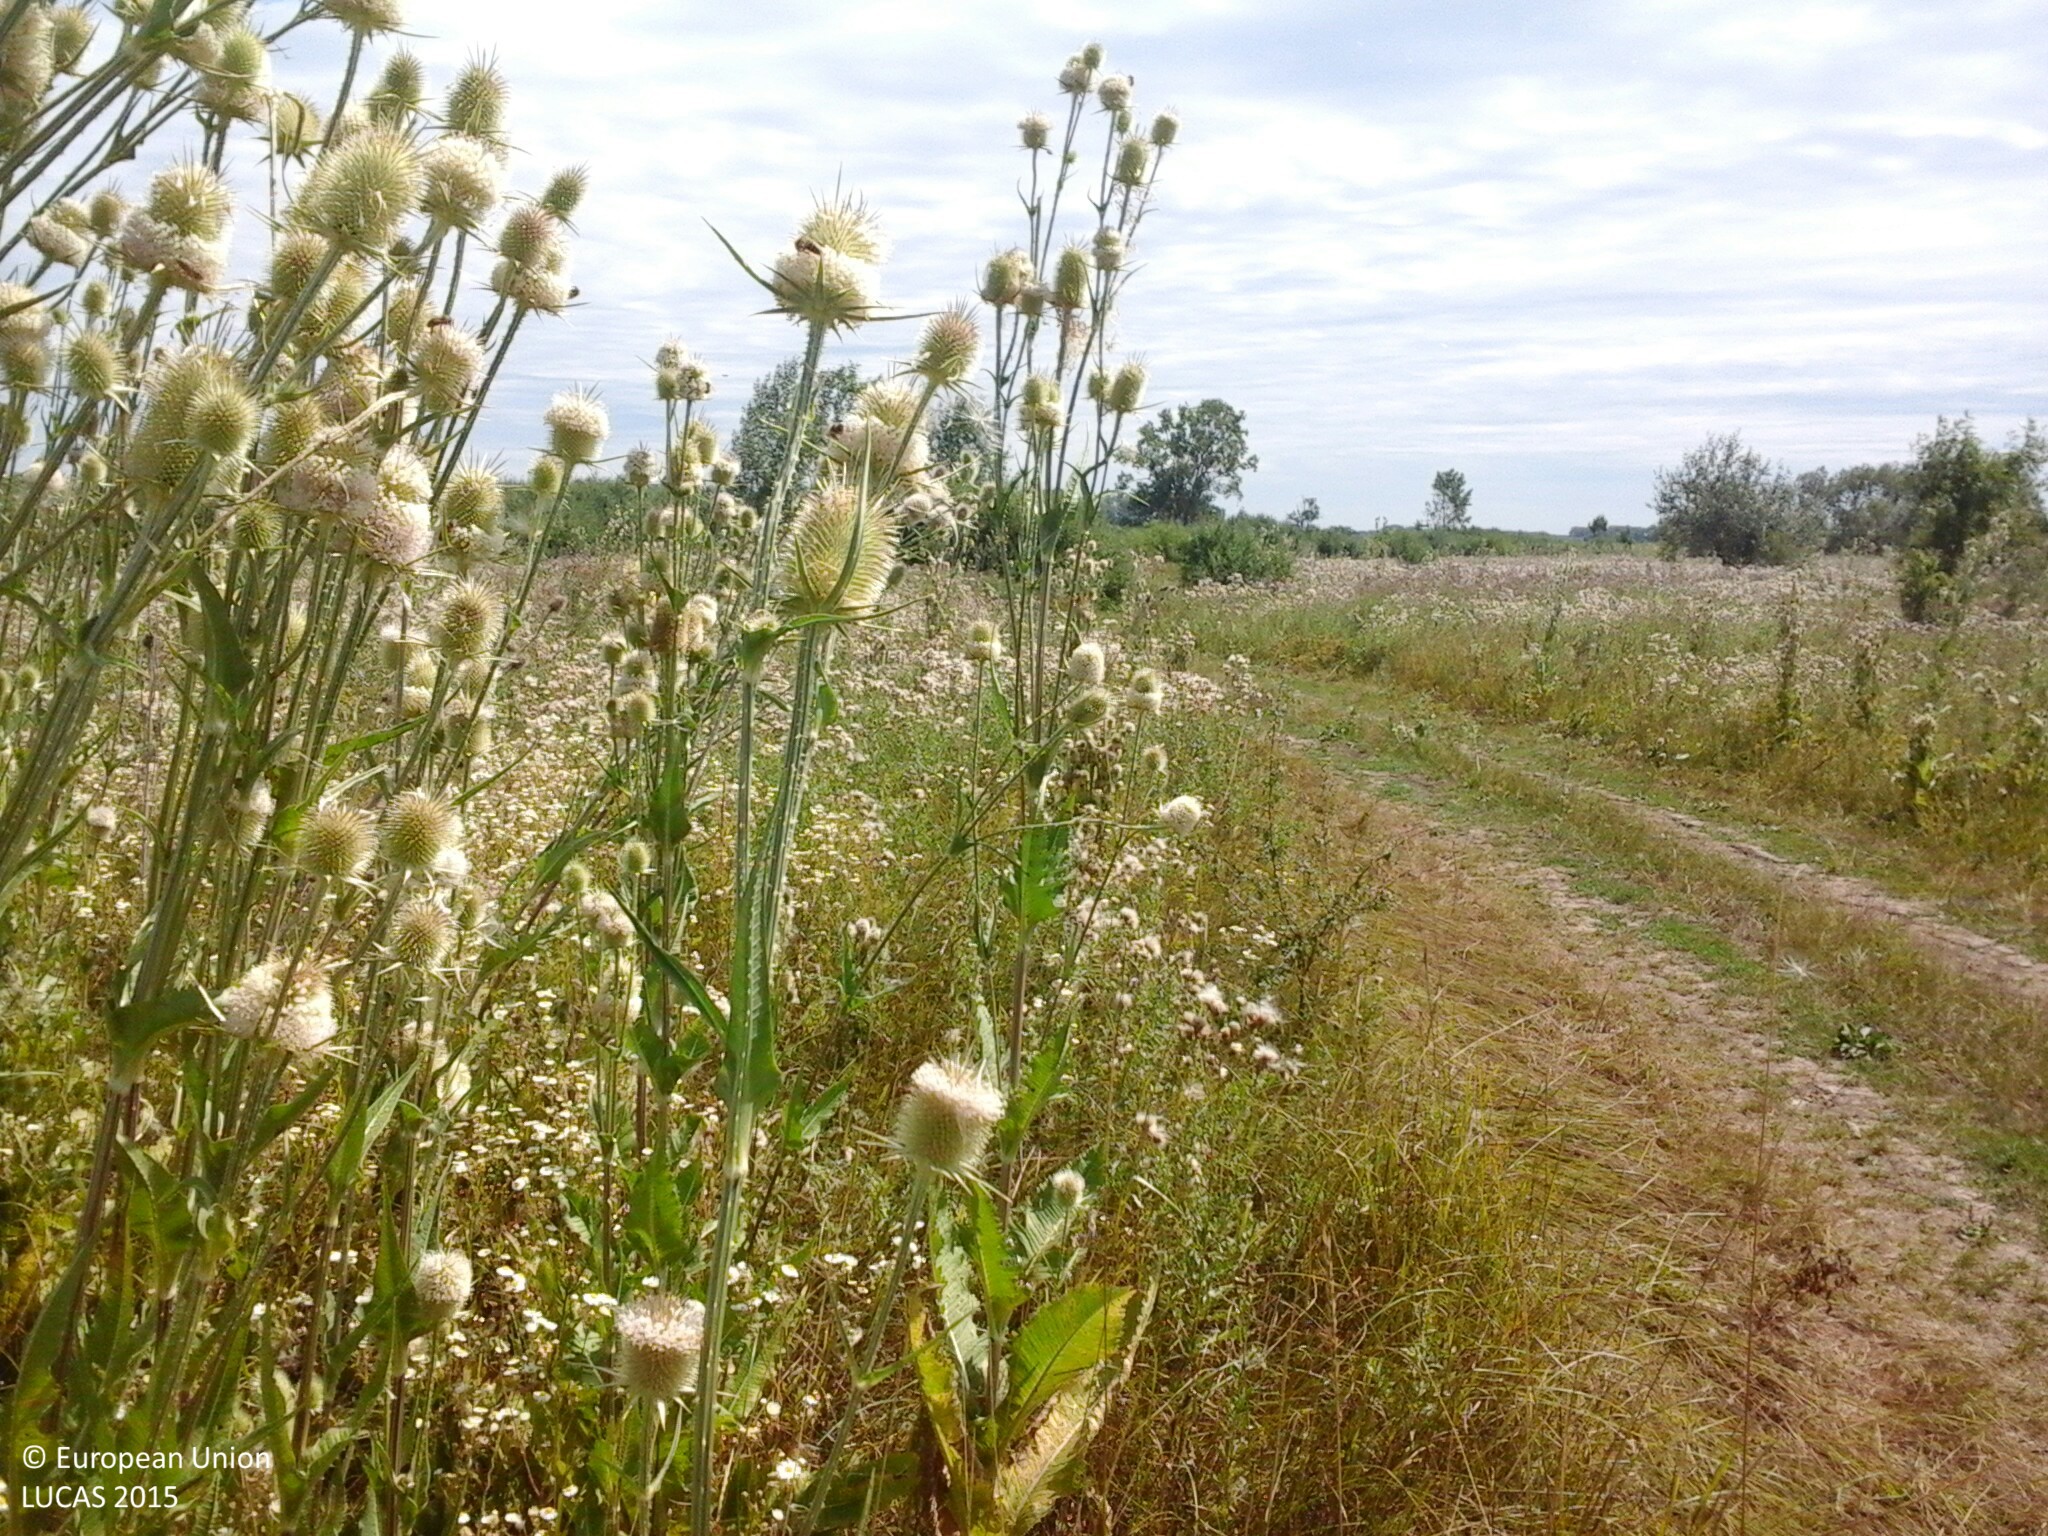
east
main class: Grassland
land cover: Spontaneously vegetated surfaces
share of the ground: > 75 %
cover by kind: herbaceous plants 100 %
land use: Semi-natural and natural areas not in use
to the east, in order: Spontaneously vegetated surfaces; Tracks; Spontaneously vegetated surfaces; Tracks; Shrubland without tree cover; Tracks; Shrubland without tree cover
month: July
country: HU
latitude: 48.0466
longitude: 22.4133
